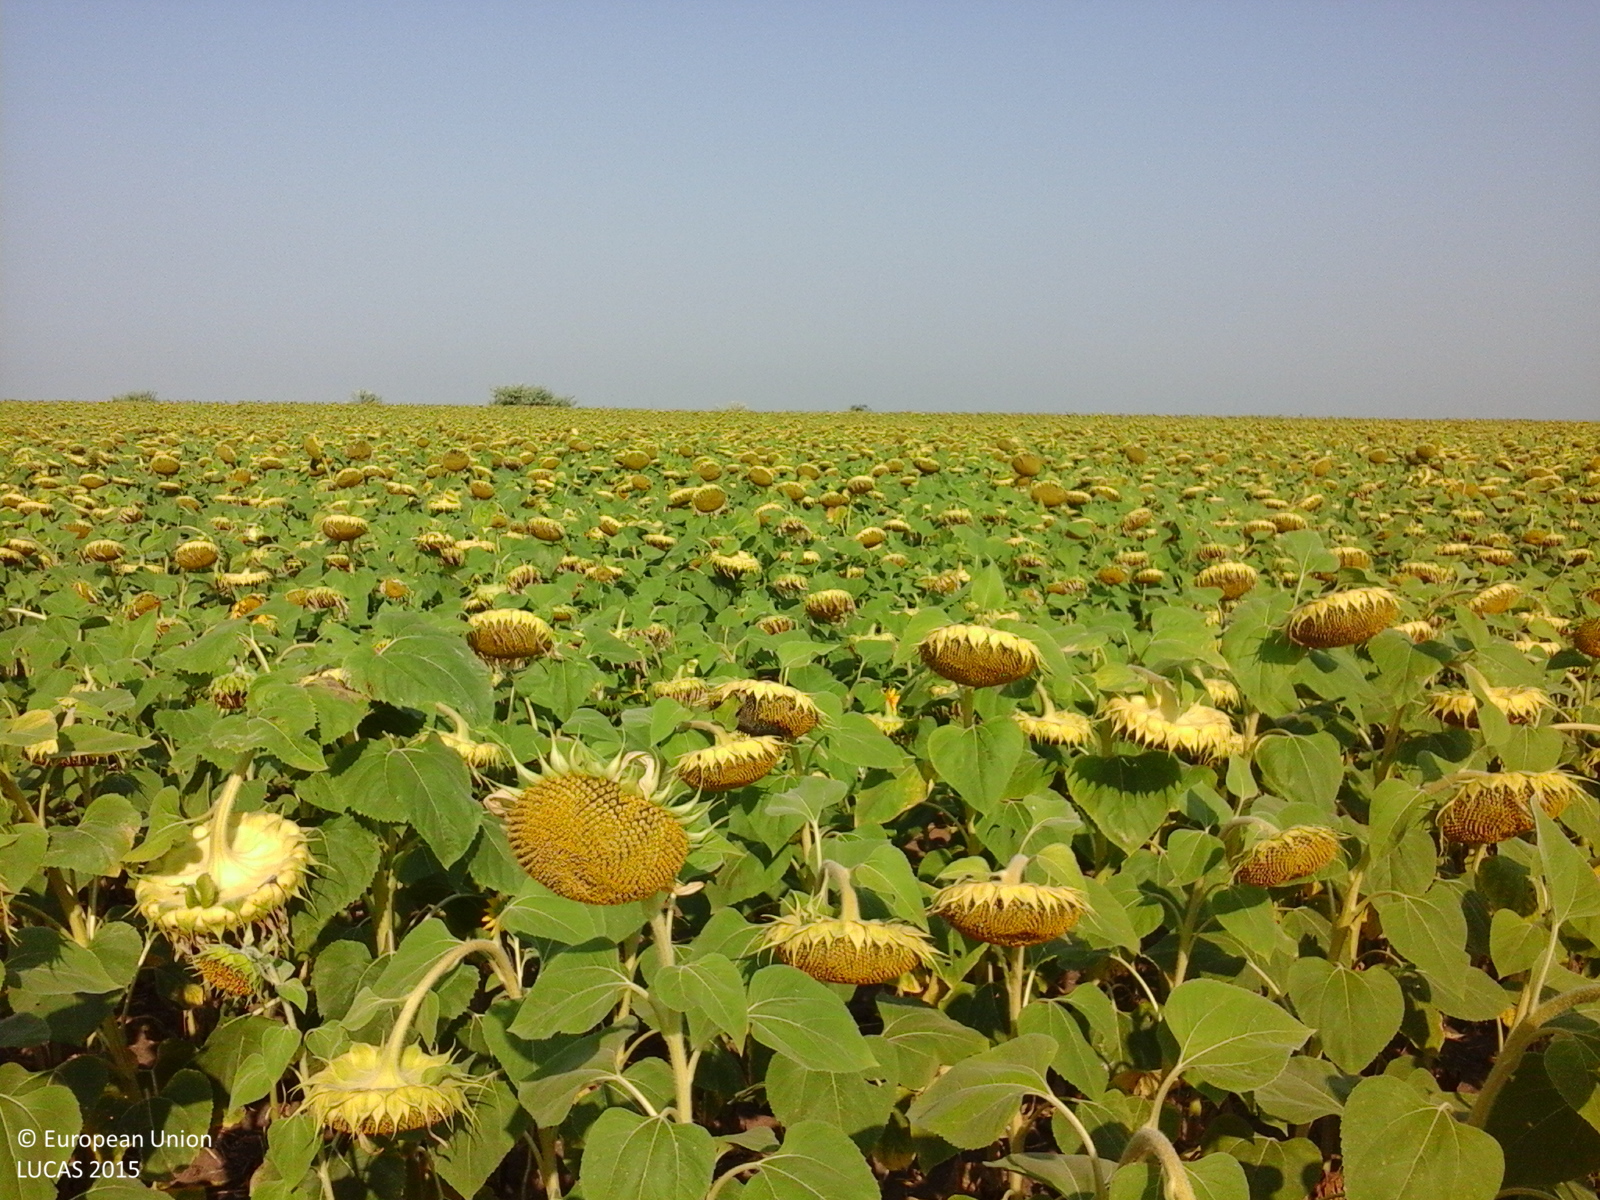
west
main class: Cropland
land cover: Sunflower
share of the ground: > 75 %
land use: Agriculture (excluding fallow land and kitchen gardens)
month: July
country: RO
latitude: 45.5299
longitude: 27.7680
